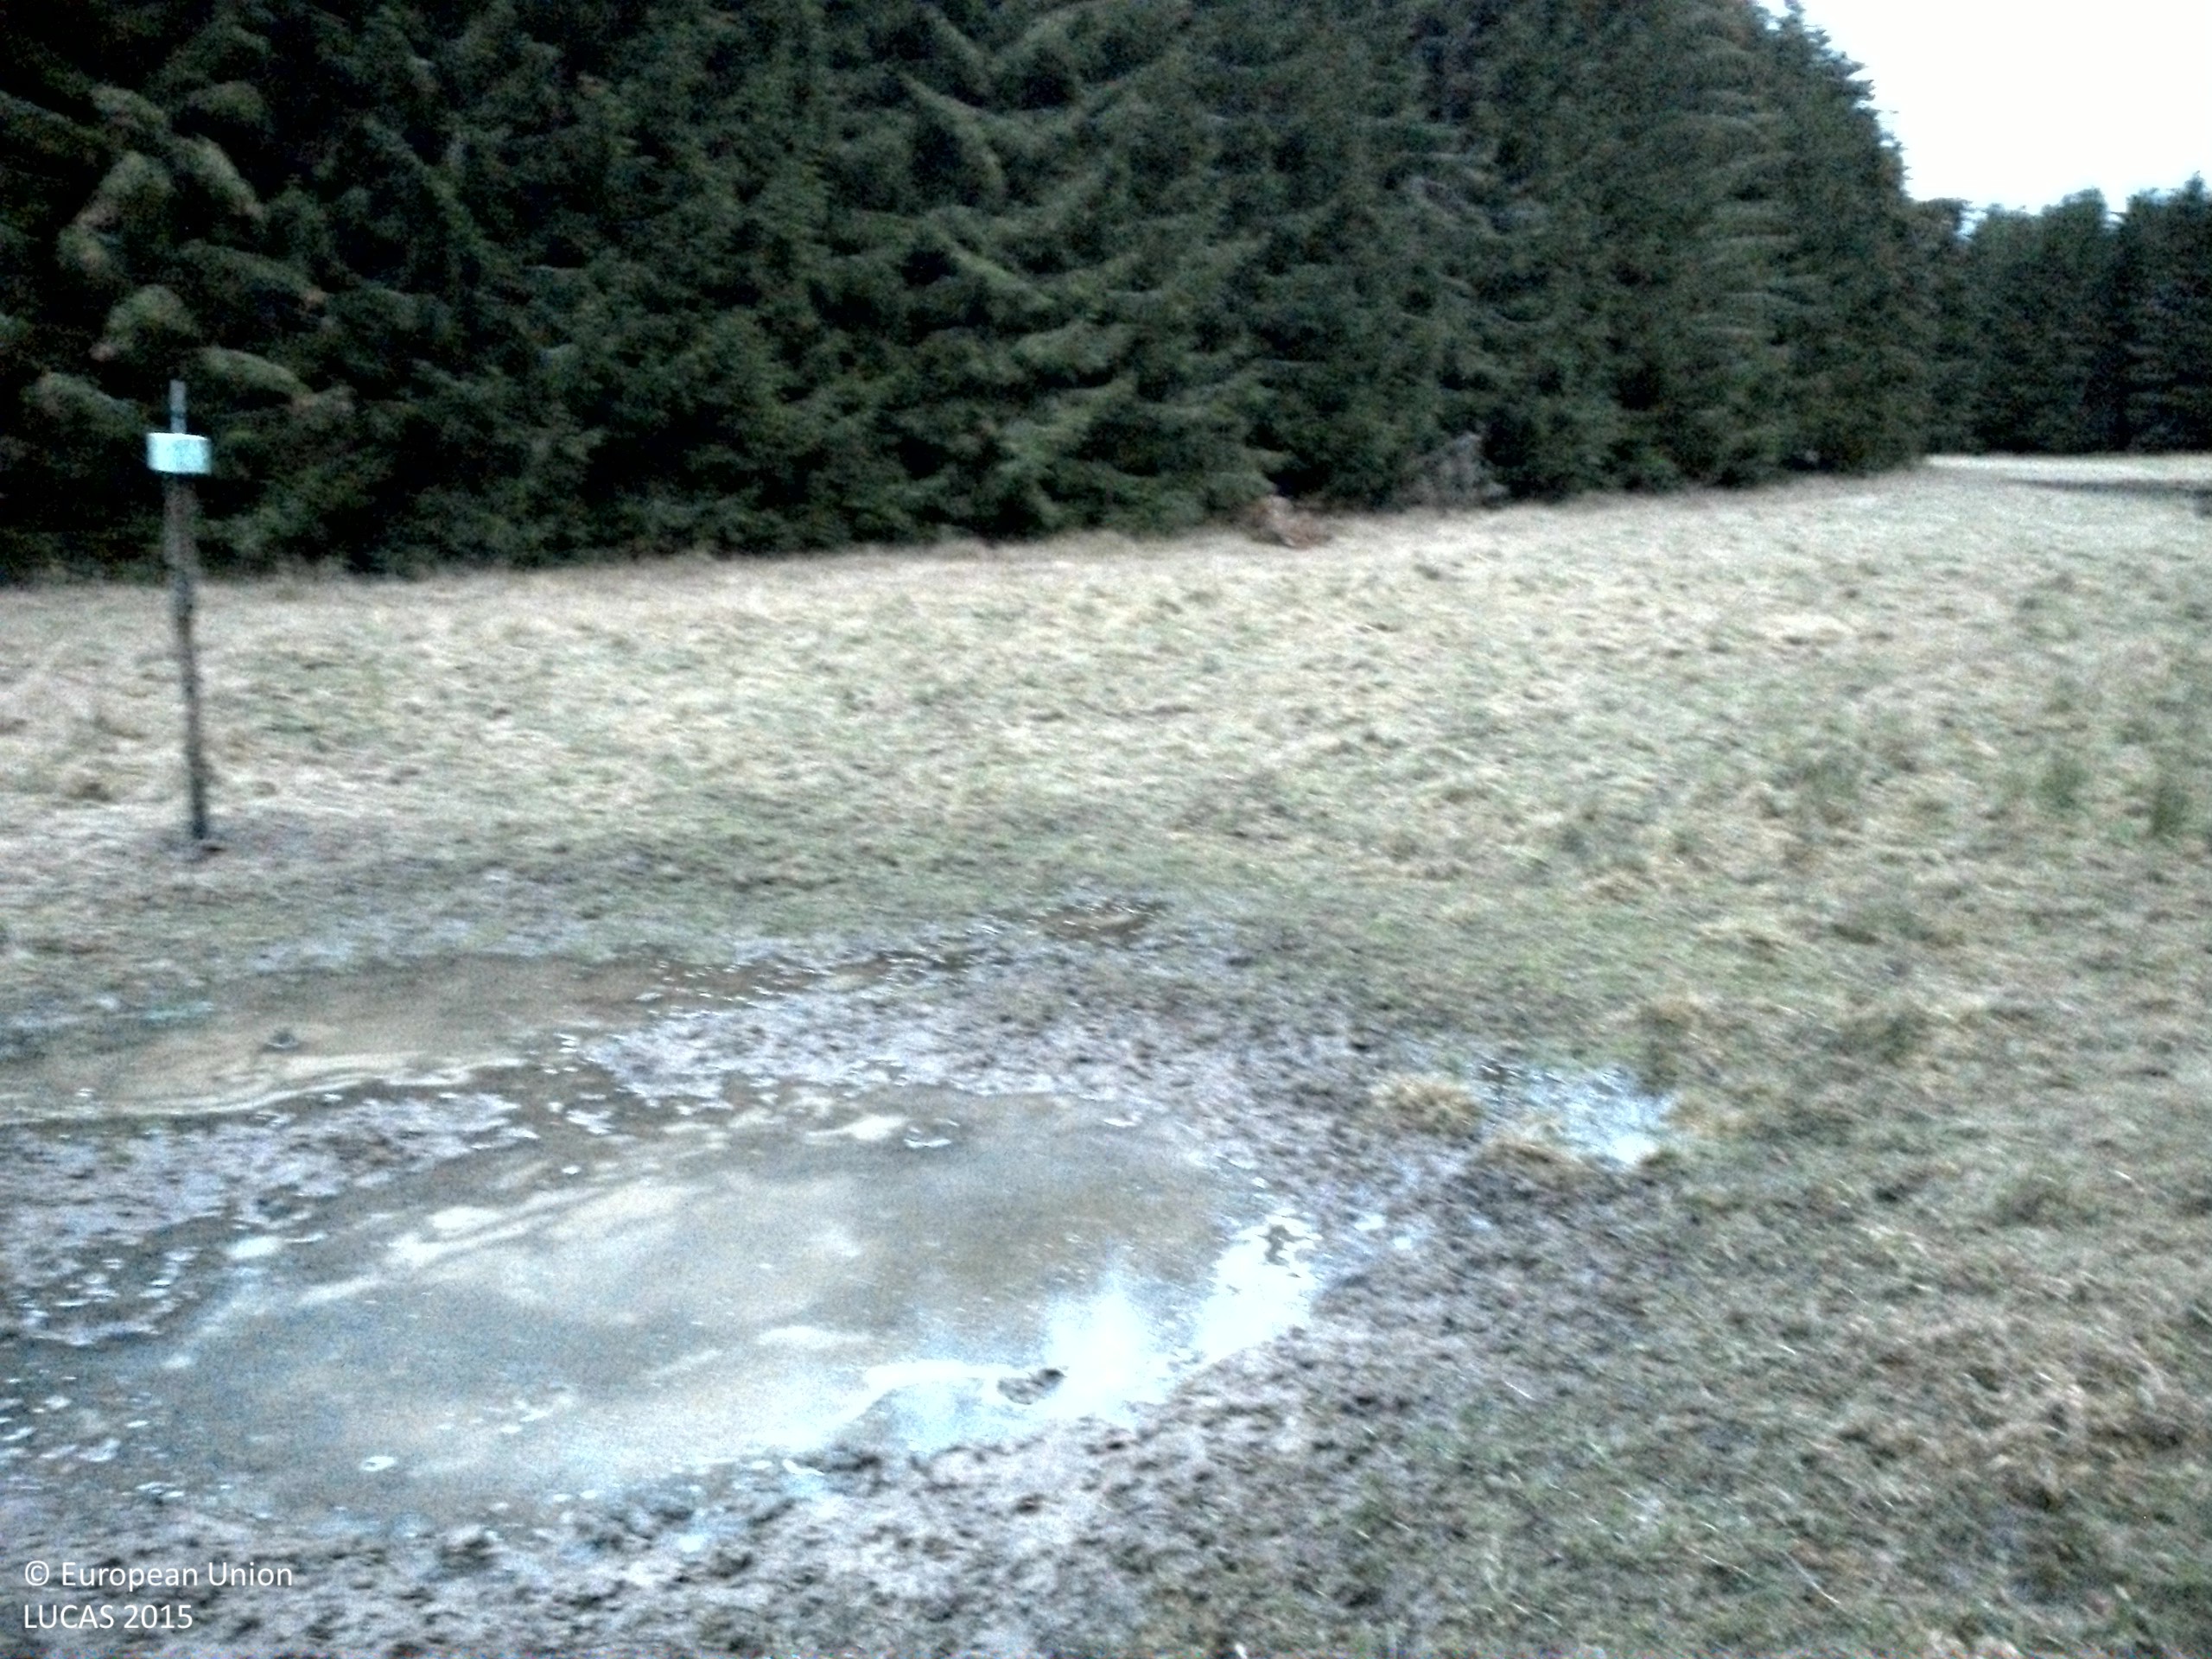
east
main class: Grassland
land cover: Grassland without tree/shrub cover
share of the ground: > 75 %
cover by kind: herbaceous plants 95 %, consolidated bare surface 5 %
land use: Other primary production
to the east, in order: Grassland without tree/shrub cover; Spruce dominated coniferous woodland; Spruce dominated mixed woodland; Spontaneously vegetated surfaces; Single bushes/trees; Grassland without tree/shrub cover
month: November
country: SE
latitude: 58.8222
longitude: 16.8366
